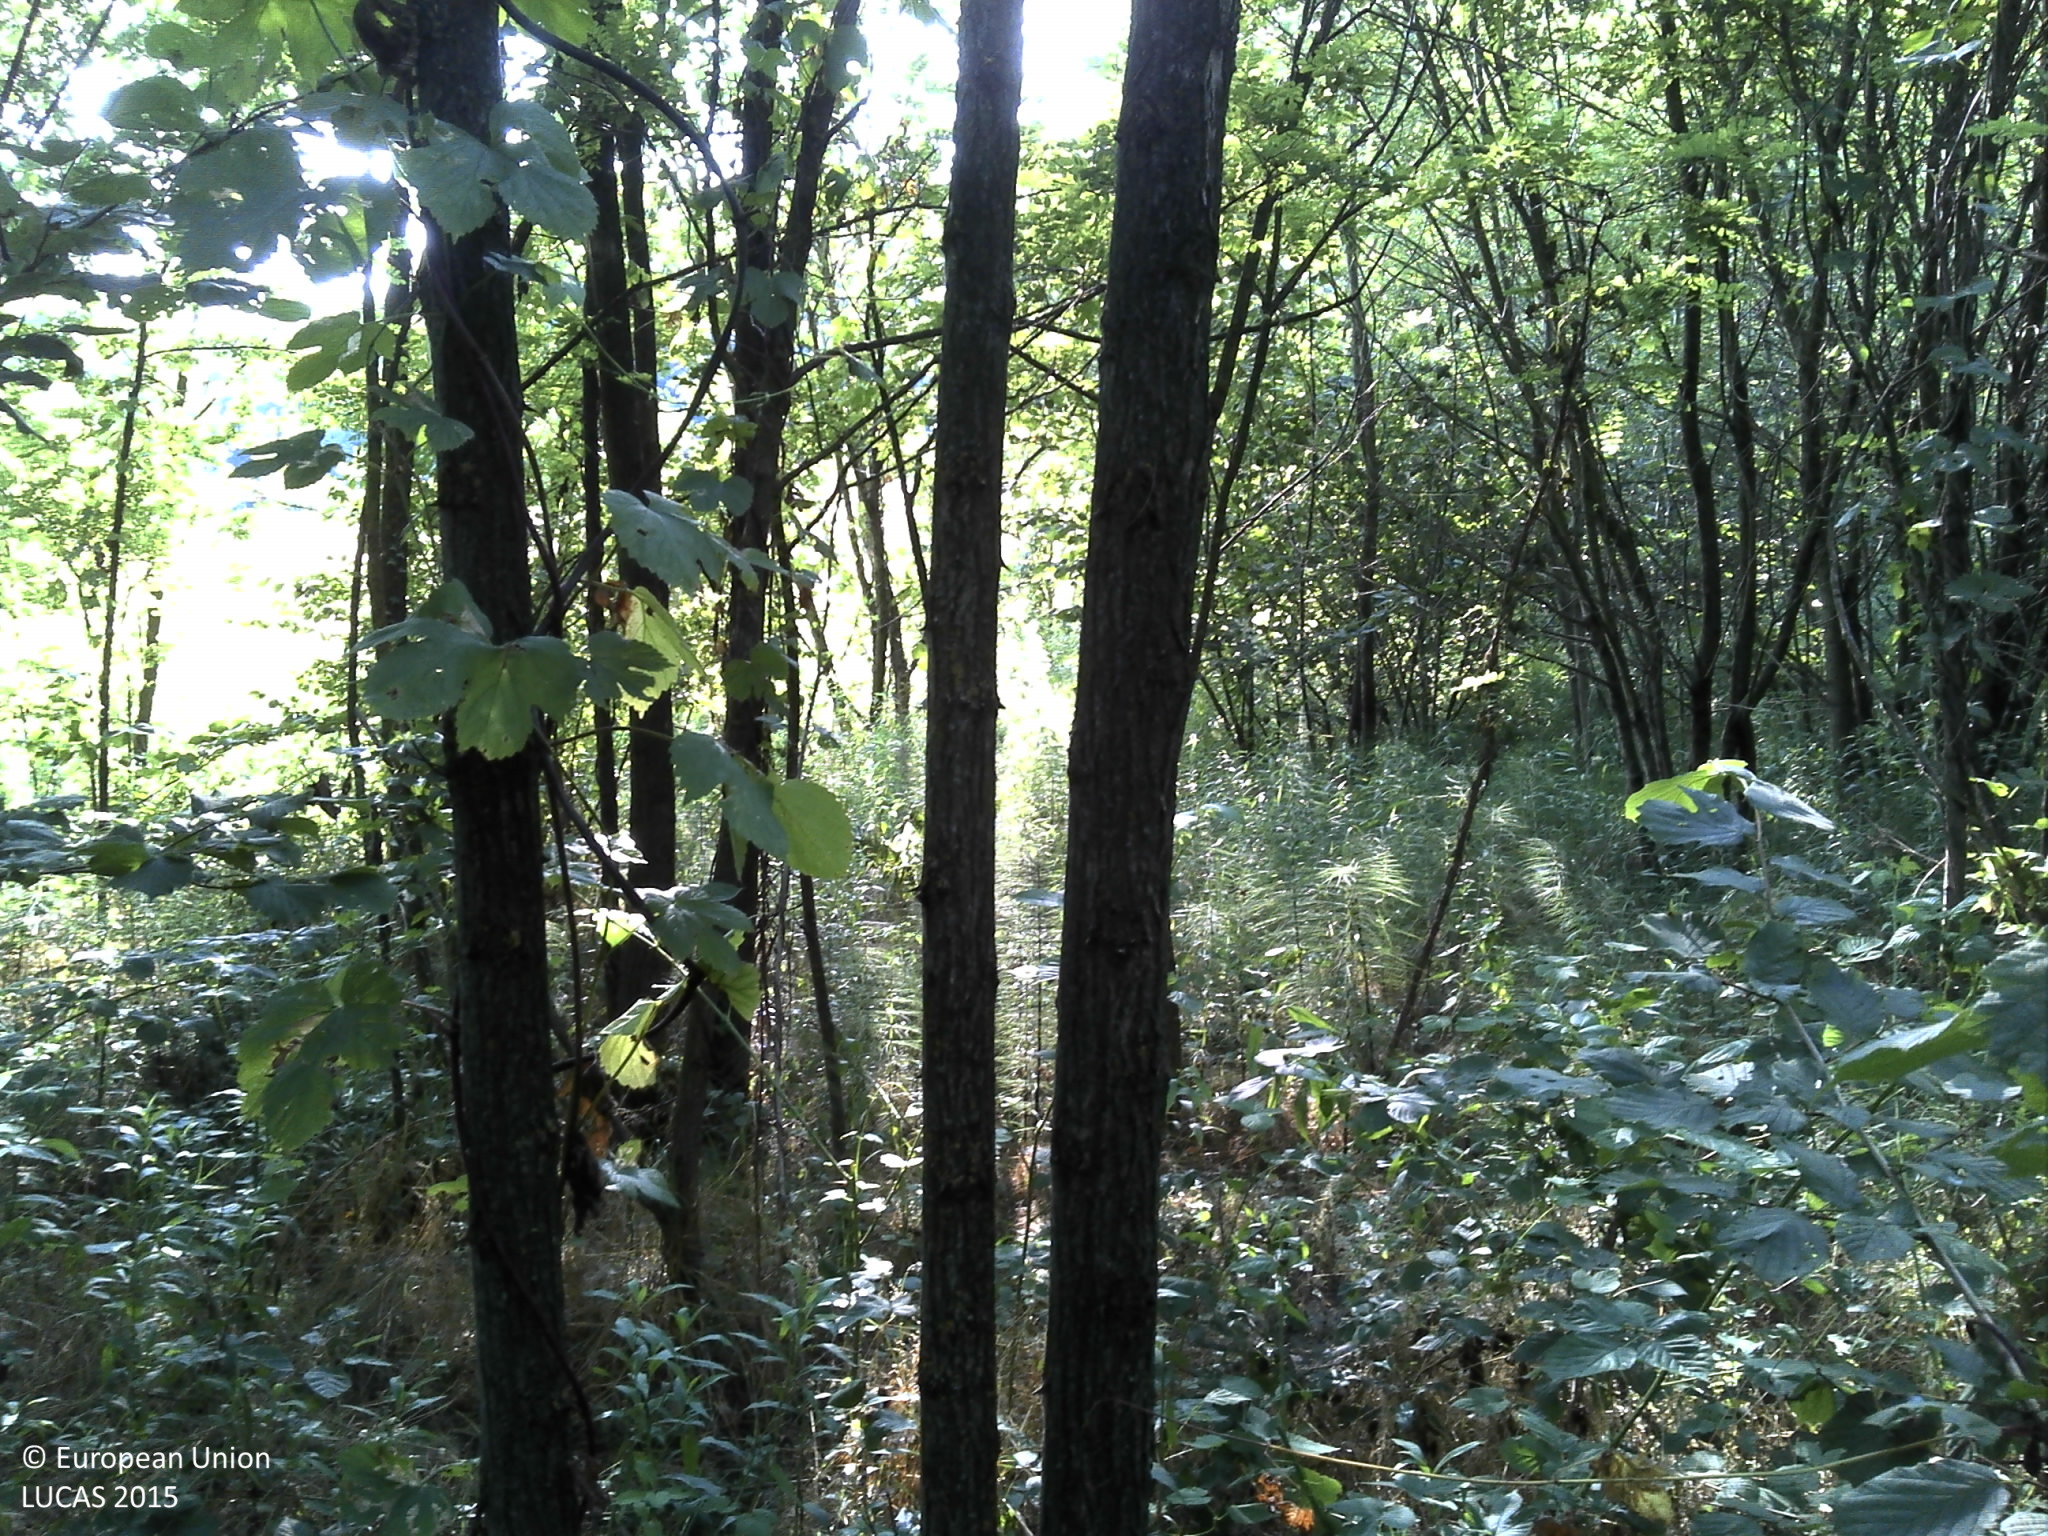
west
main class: Shrubland
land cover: Shrubland with sparse tree cover
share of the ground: > 75 %
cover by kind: shrubs 95 %, broadleaved forest trees 5 %
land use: Semi-natural and natural areas not in use
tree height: < 5 m
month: July
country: HR
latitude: 45.5073
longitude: 16.7184
